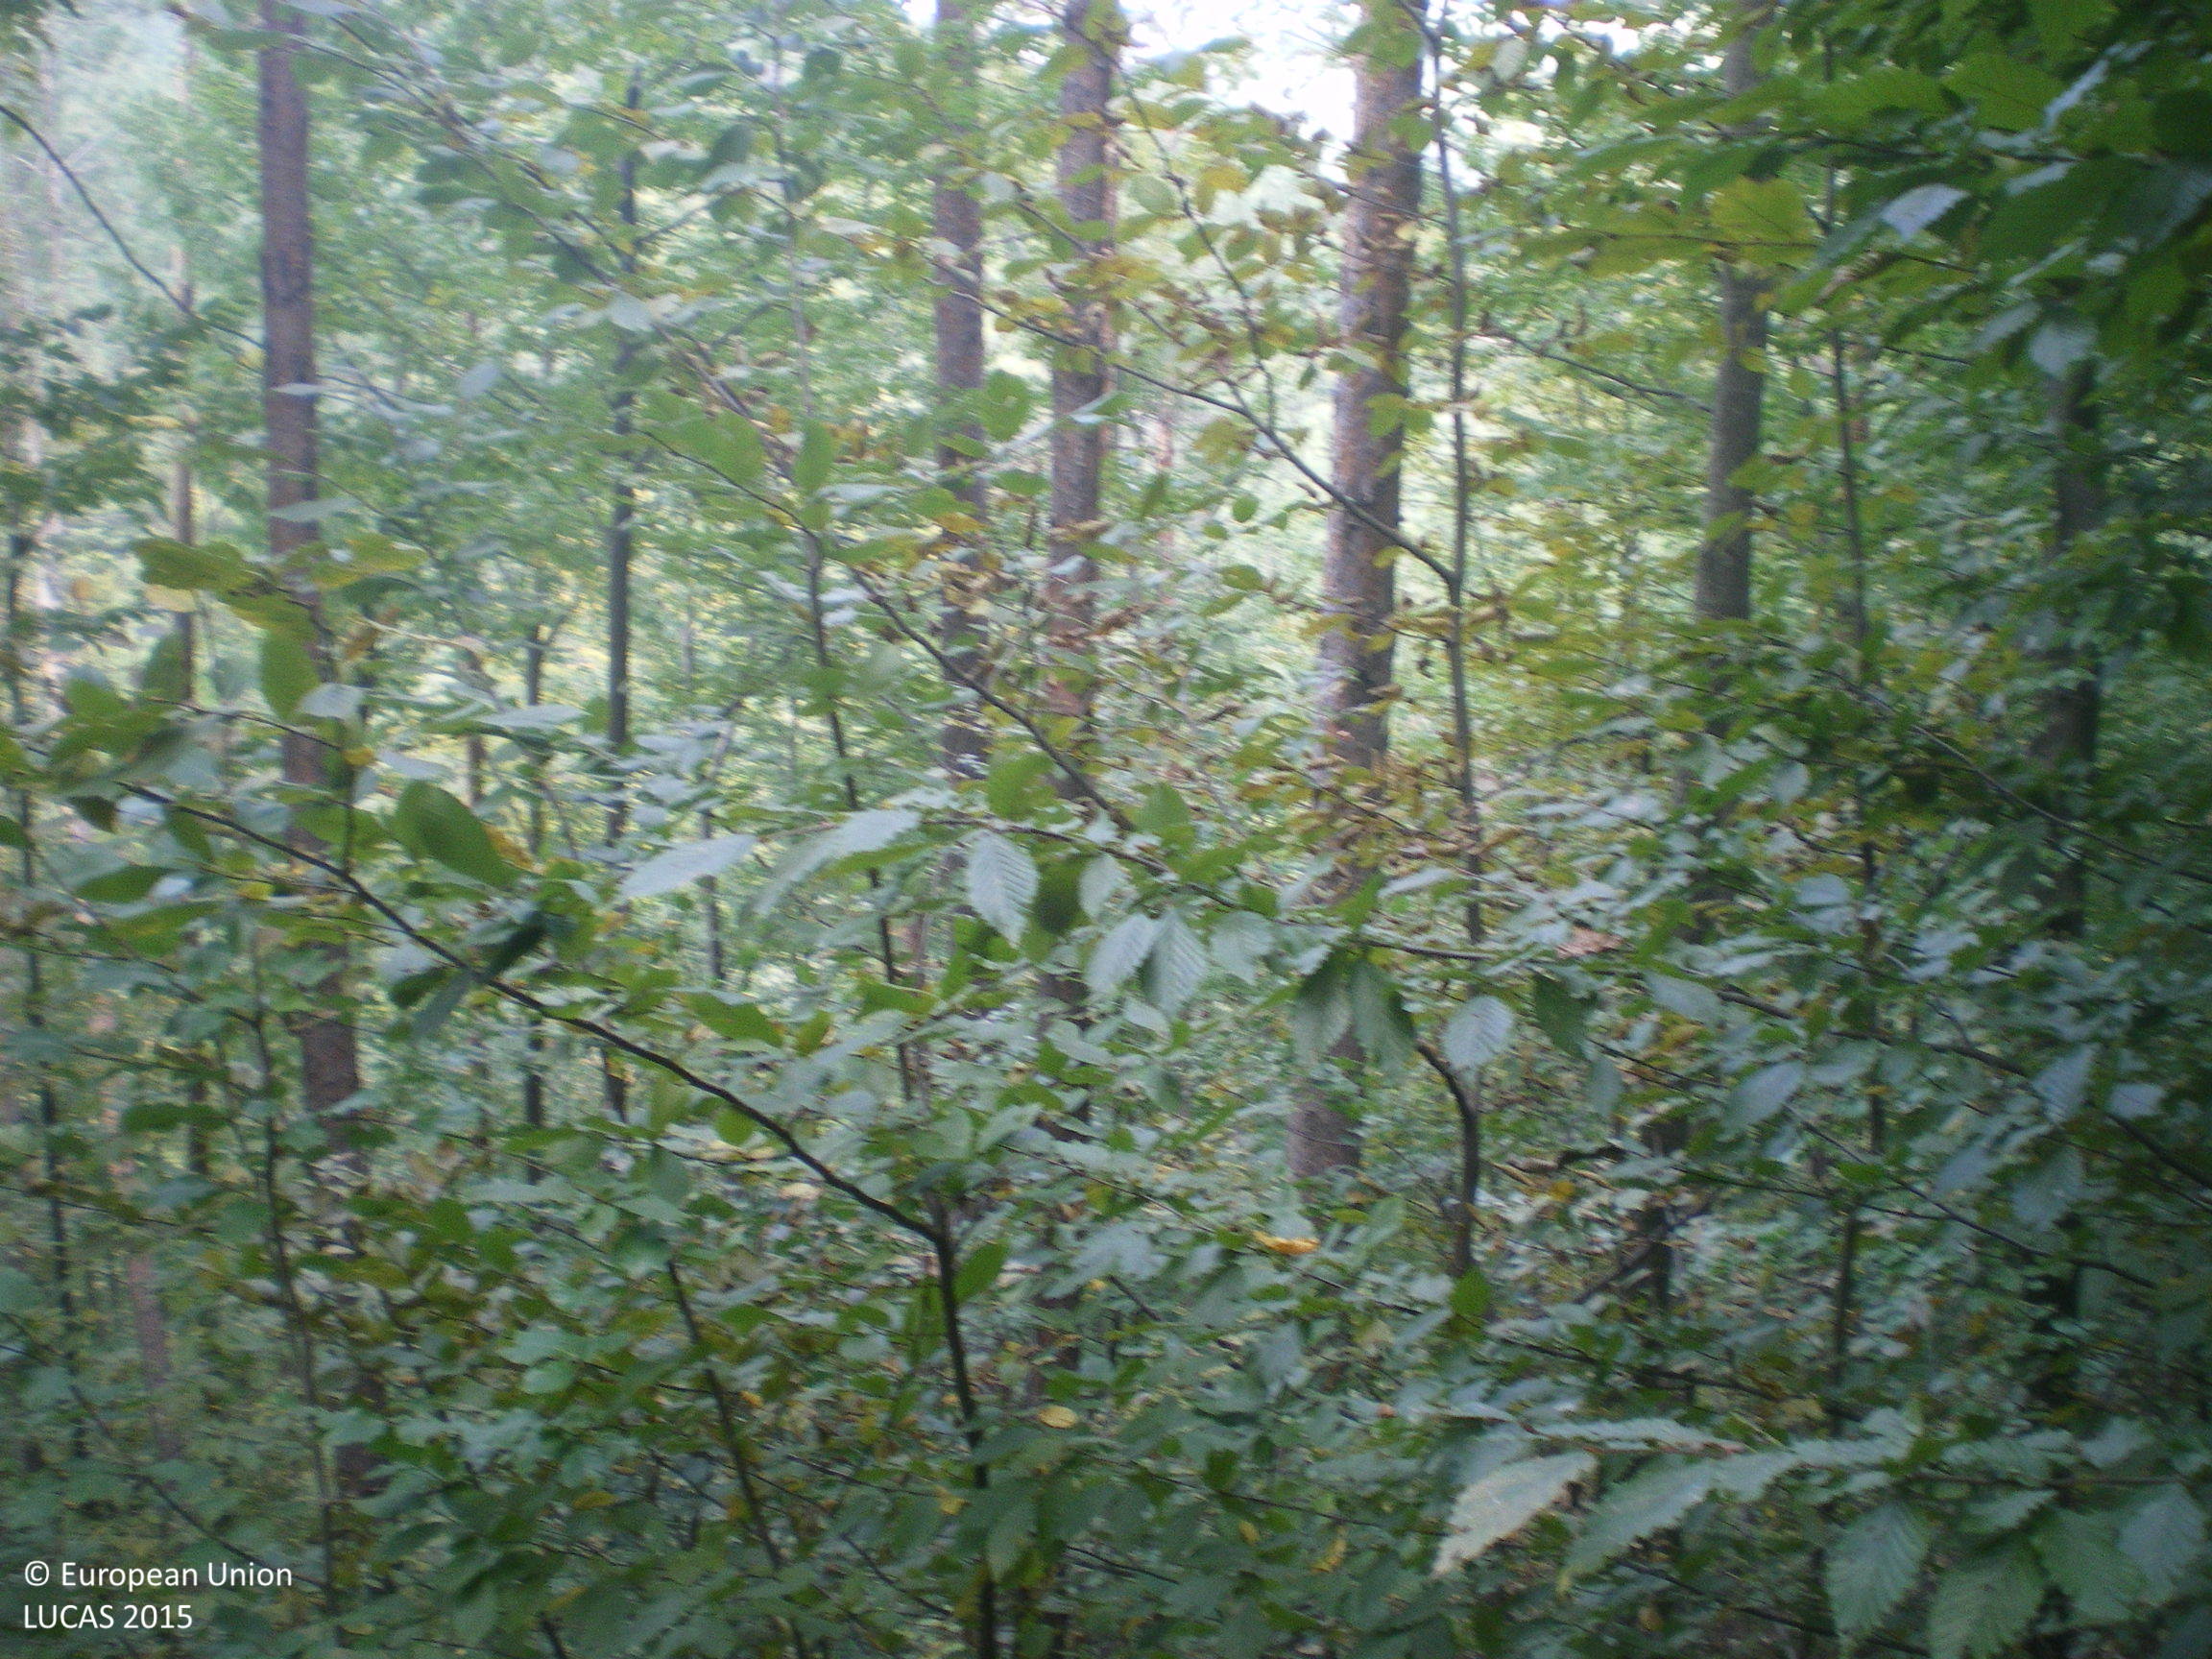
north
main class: Woodland
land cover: Pine dominated mixed woodland
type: hemiboreal forest and nemoral coniferous forest and mixed broadleaved-coniferous forest
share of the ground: > 75 %
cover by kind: coniferous forest trees 60 %, broadleaved forest trees 25 %, shrubs 15 %
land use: Forestry
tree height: > 5 m
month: October
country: BG
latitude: 42.7287
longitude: 25.6726
